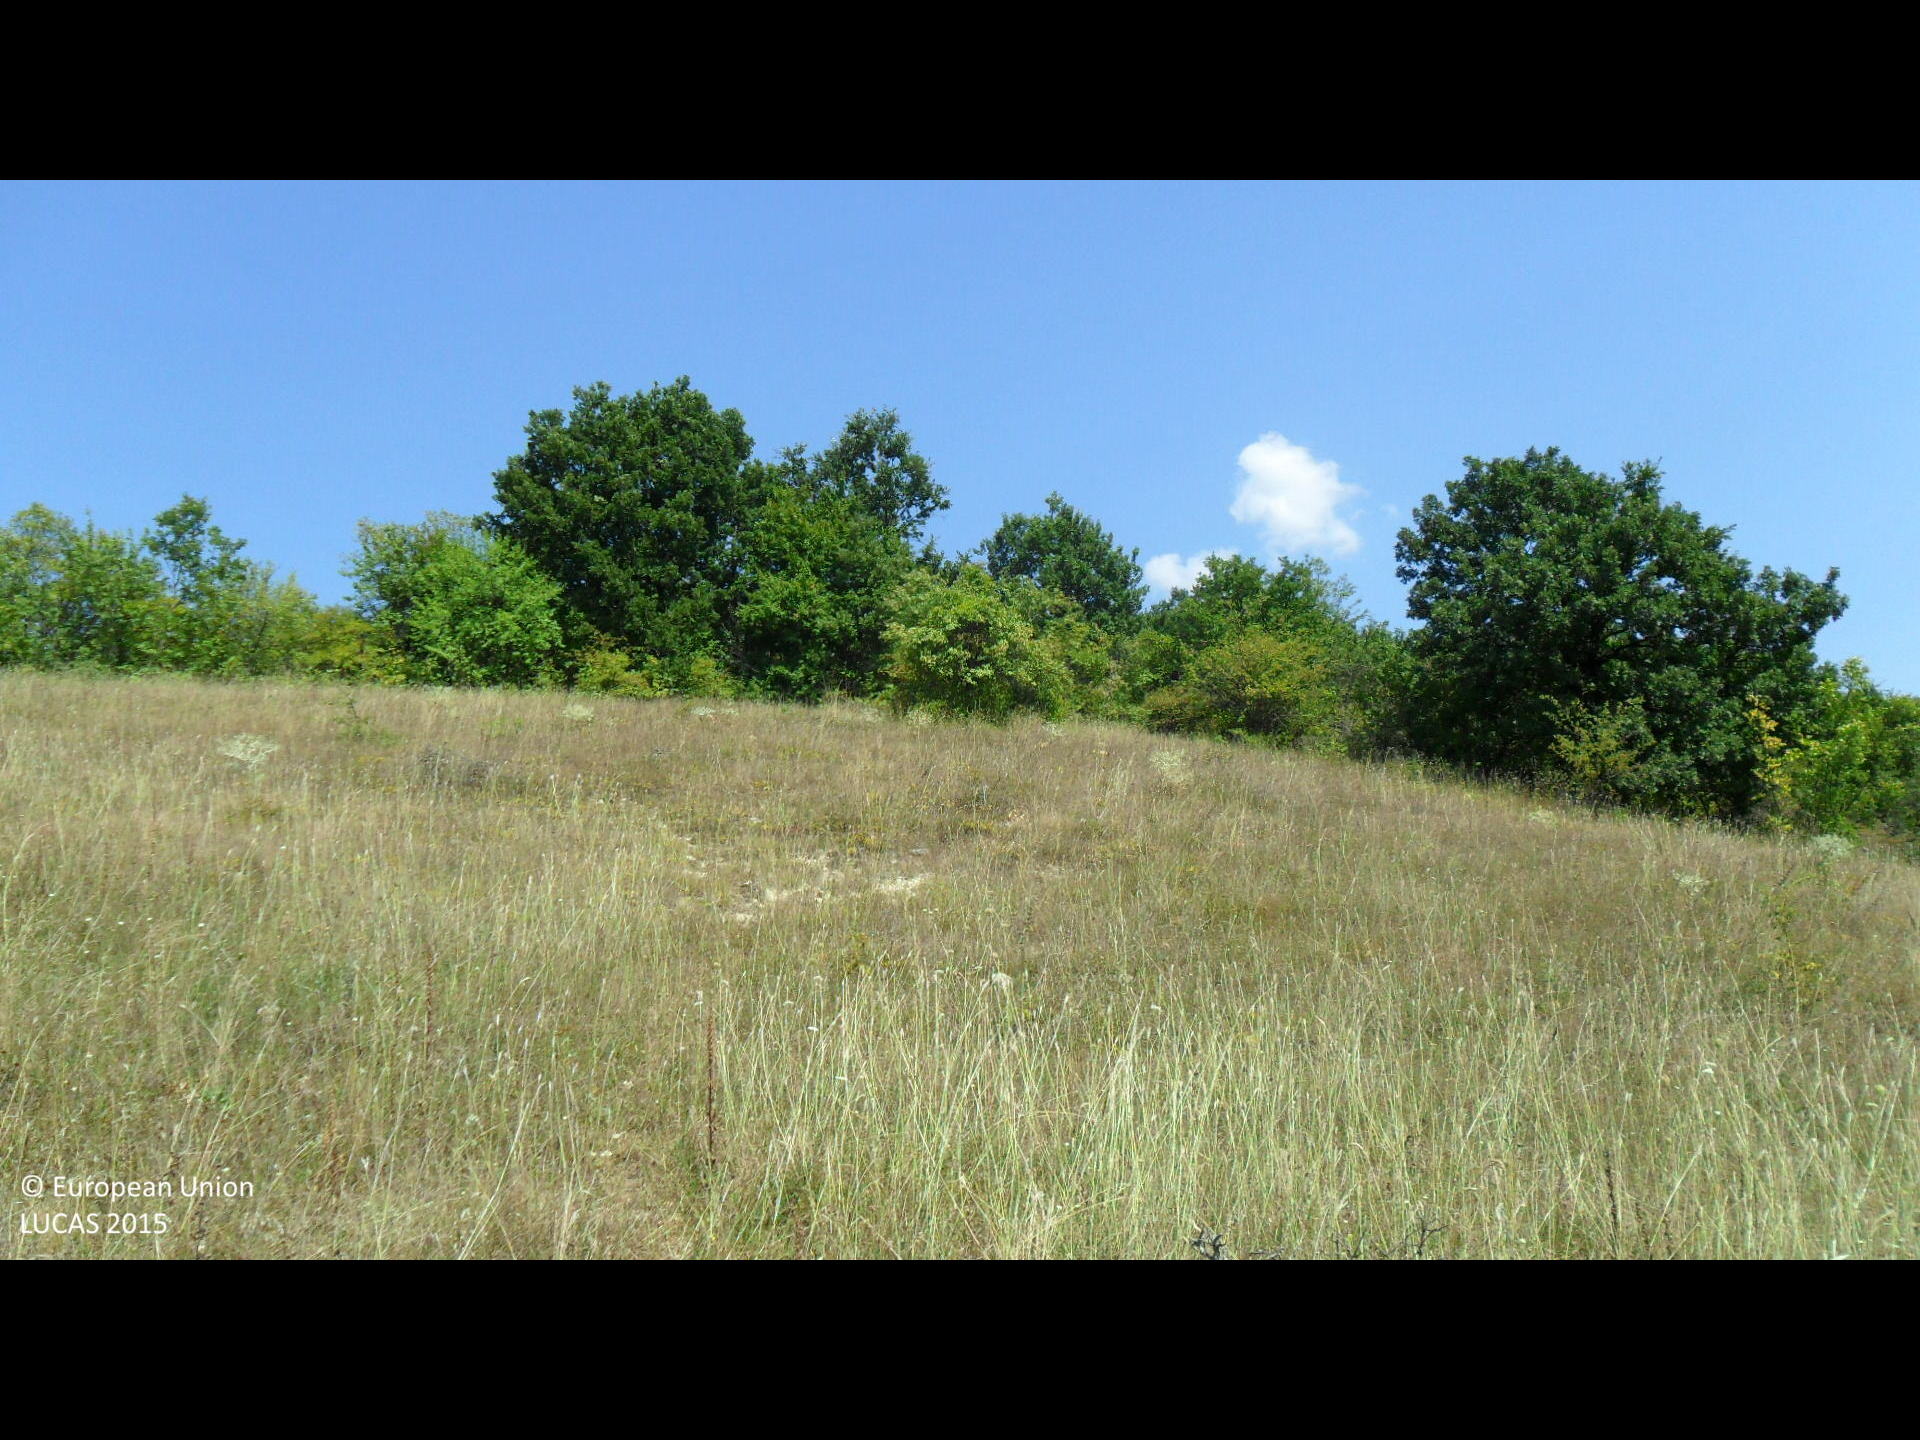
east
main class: Grassland
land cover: Grassland with sparse tree/shrub cover
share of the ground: > 75 %
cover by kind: herbaceous plants 90 %, broadleaved forest trees 5 %, shrubs 5 %
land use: Agriculture (excluding fallow land and kitchen gardens)
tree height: < 5 m
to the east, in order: Grassland with sparse tree/shrub cover; Broadleaved woodland; Grassland with sparse tree/shrub cover; Broadleaved woodland
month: August
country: BG
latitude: 43.4785
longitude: 26.1557
